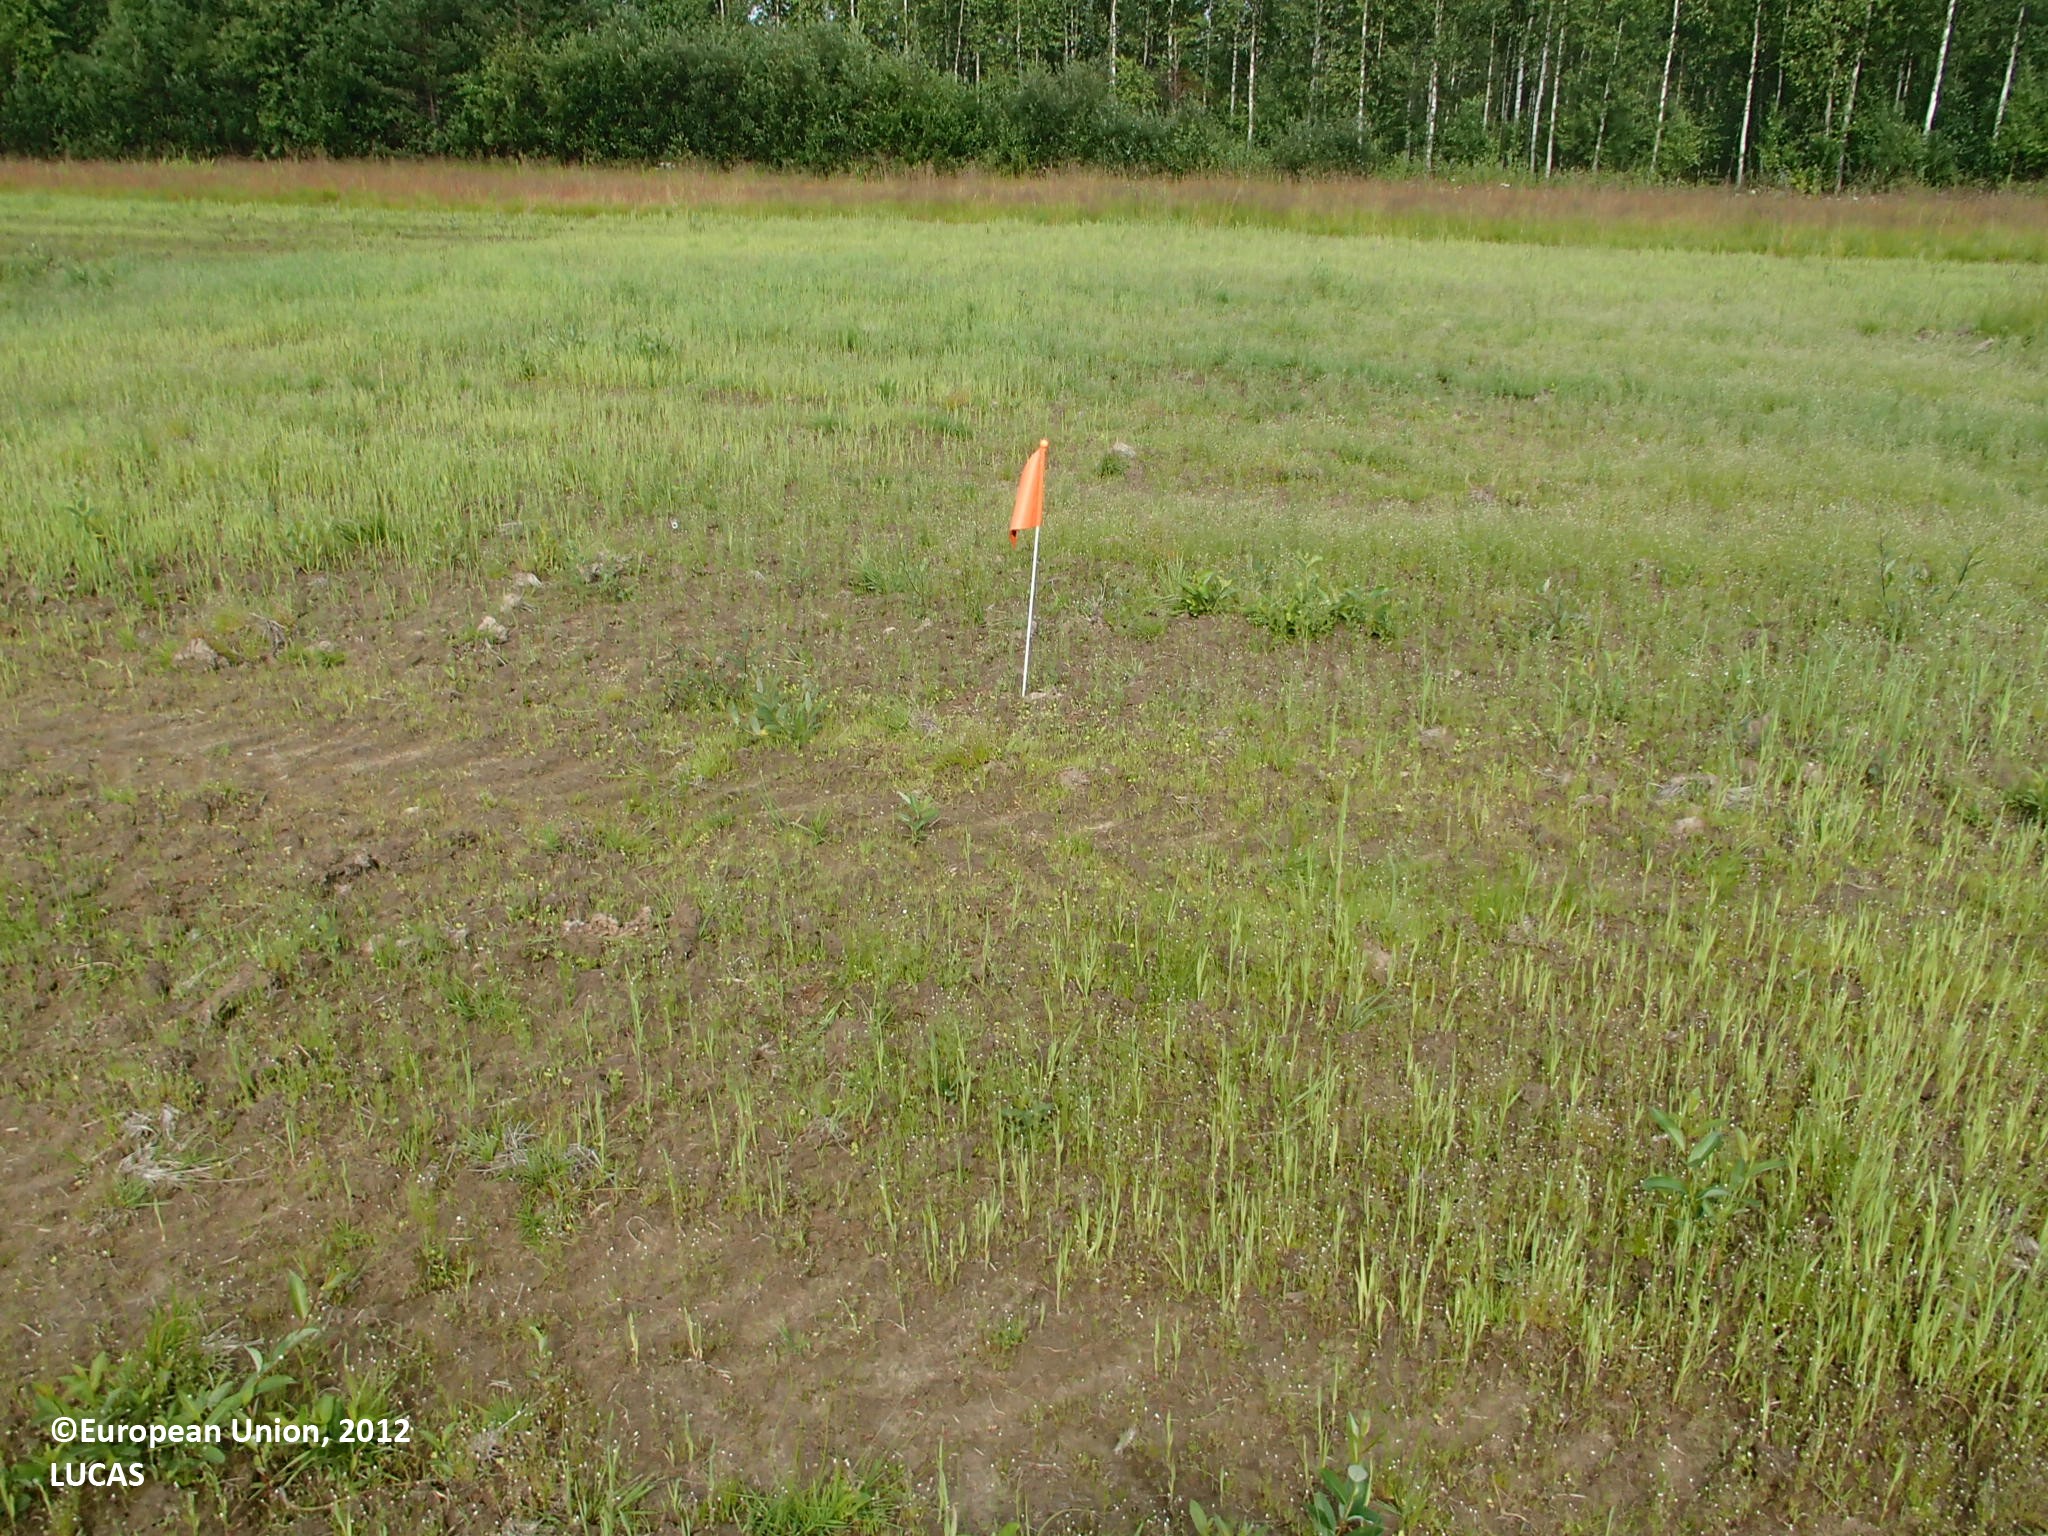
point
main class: Cropland
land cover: Temporary grasslands
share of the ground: 50 - 75 %
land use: Agriculture (excluding fallow land and kitchen gardens)
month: July
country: FI
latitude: 66.1829
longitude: 25.3104
